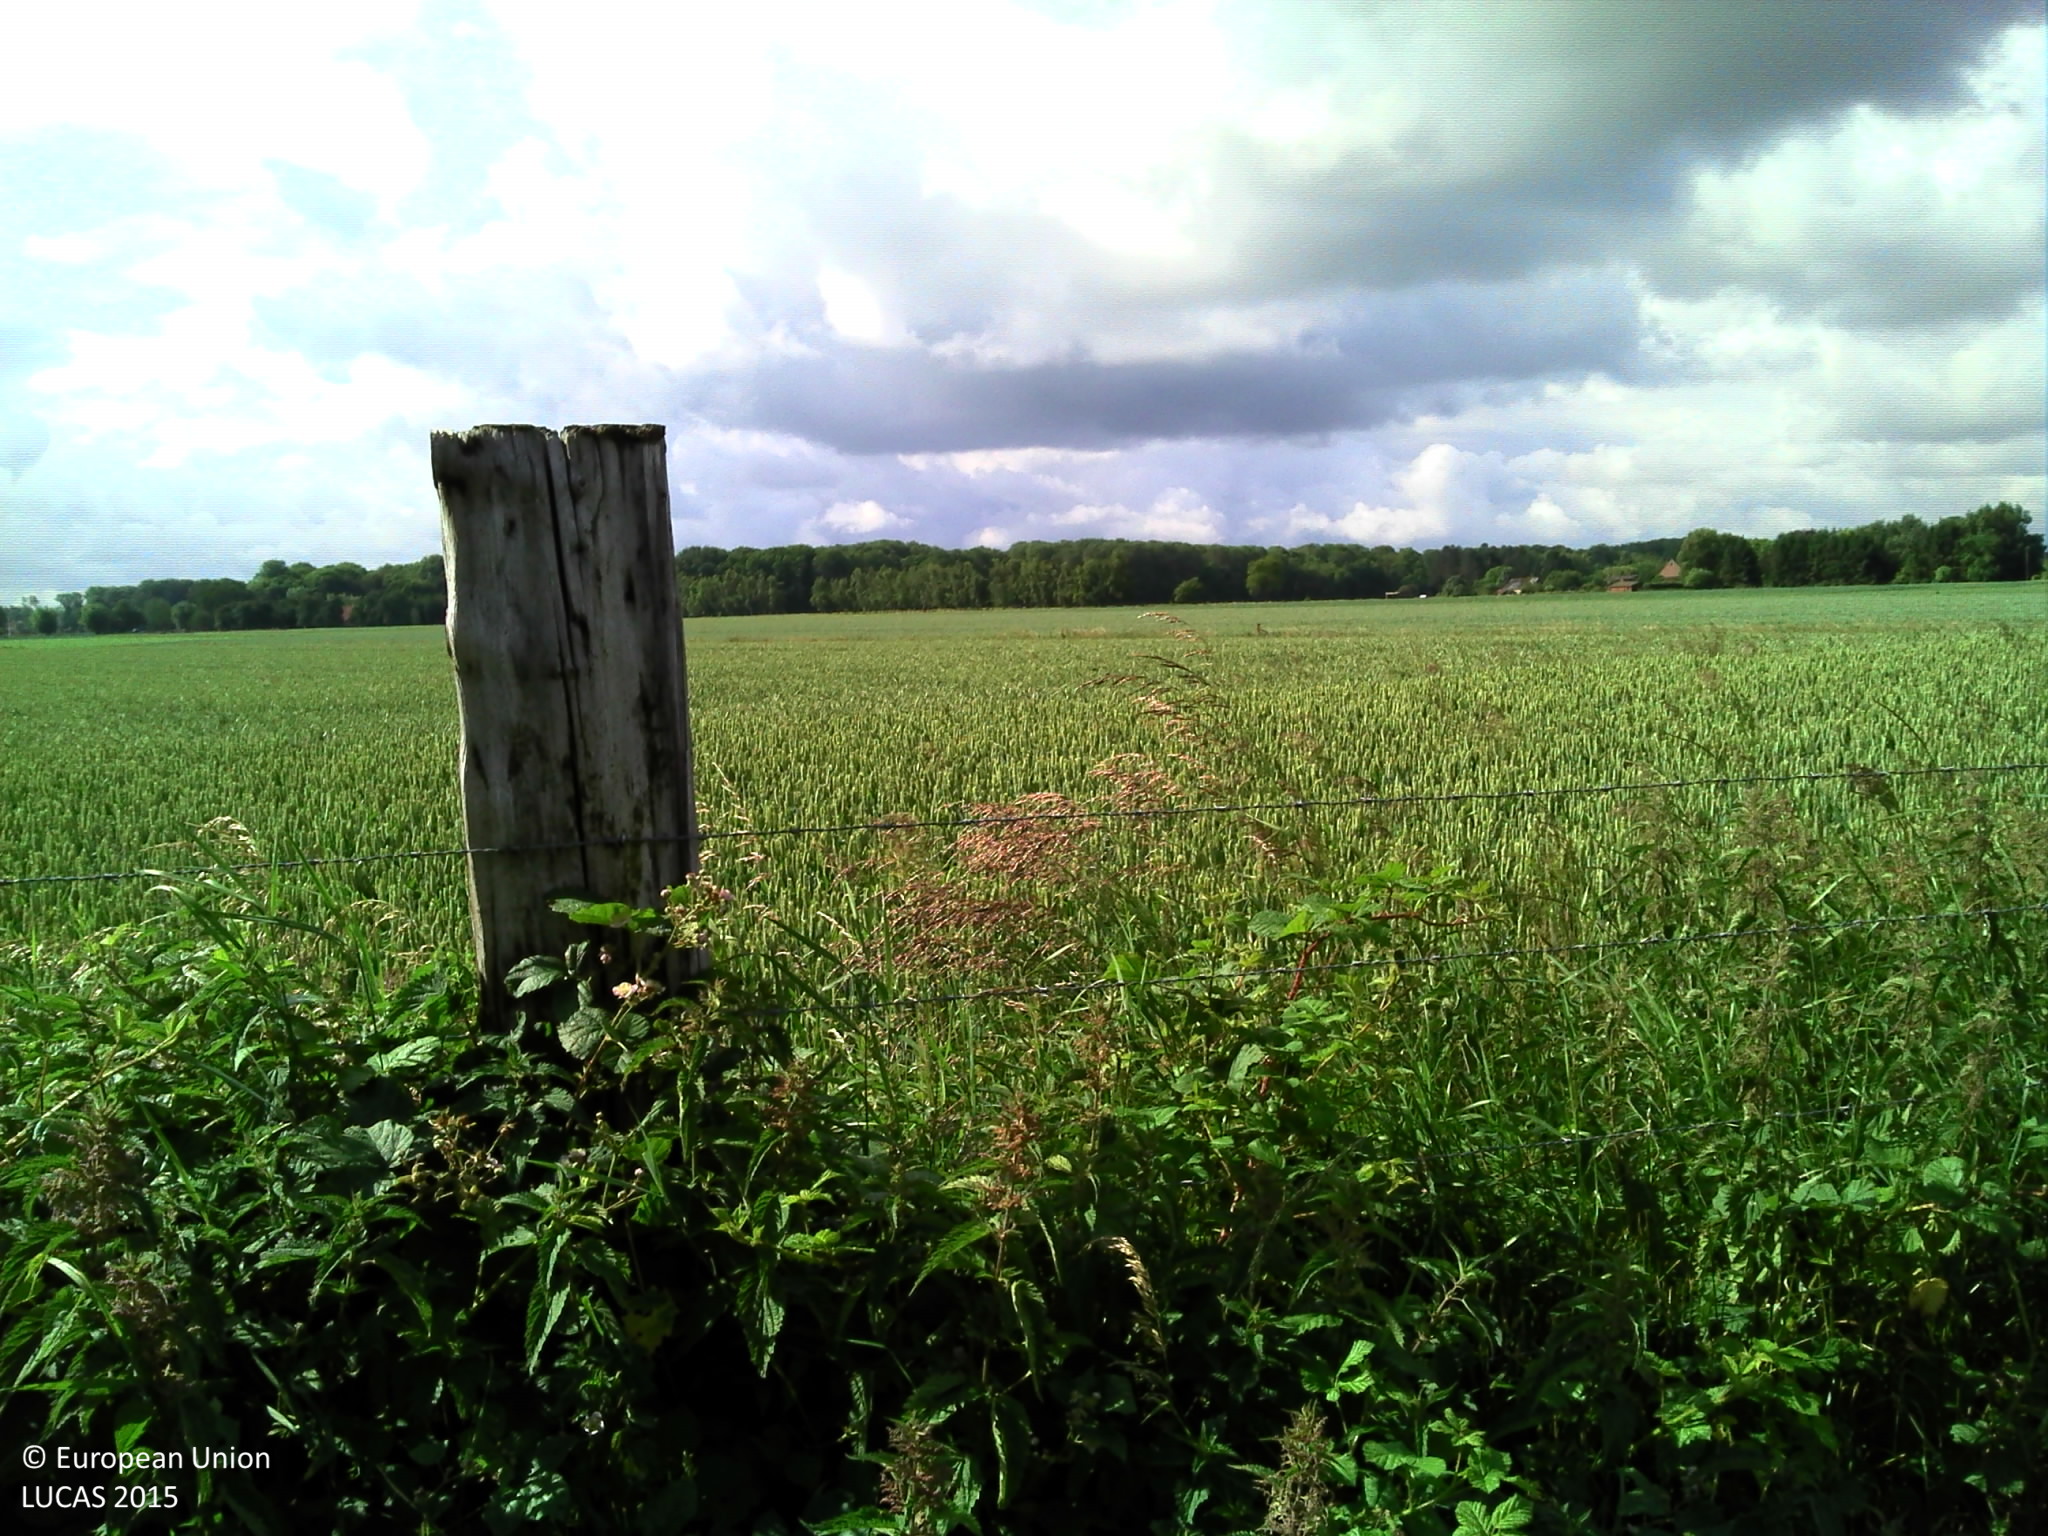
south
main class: Grassland
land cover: Grassland with sparse tree/shrub cover
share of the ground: 50 - 75 %
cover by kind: herbaceous plants 85 %, shrubs 10 %, broadleaved forest trees 5 %
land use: Agriculture (excluding fallow land and kitchen gardens)
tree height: > 5 m
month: June
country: BE
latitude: 50.5281
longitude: 3.9422
